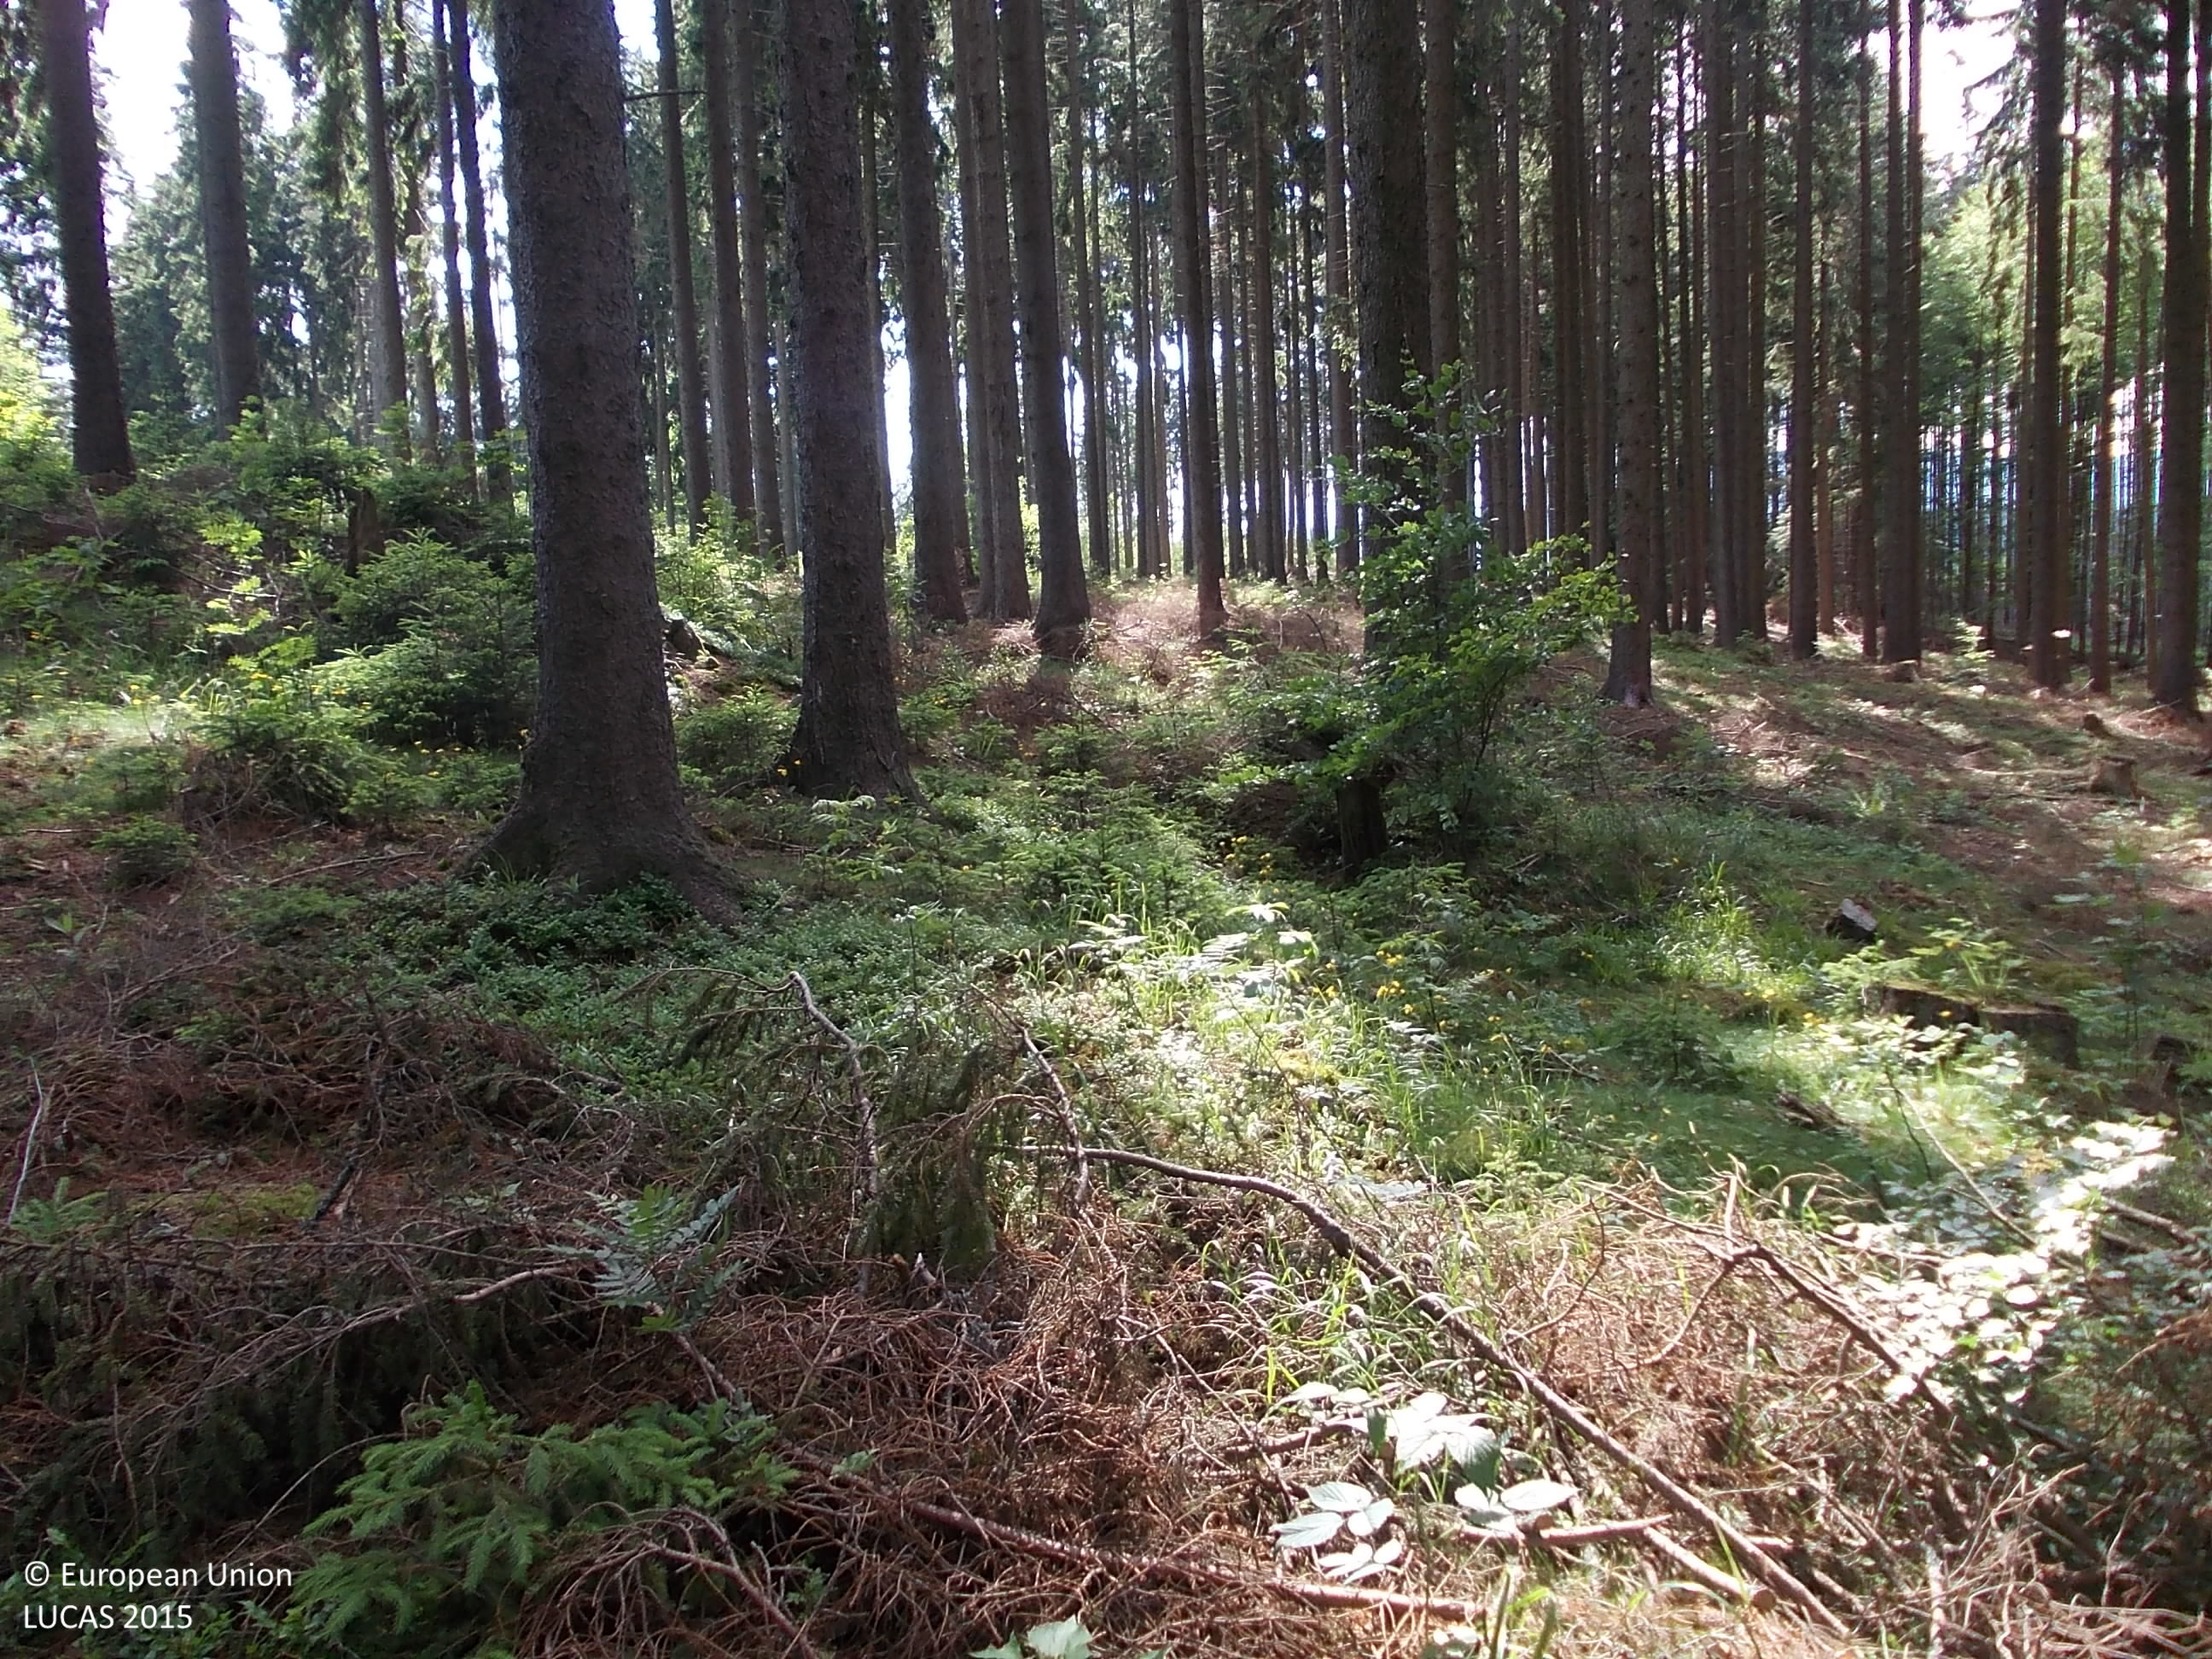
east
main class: Woodland
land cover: Spruce dominated coniferous woodland
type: hemiboreal forest and nemoral coniferous forest and mixed broadleaved-coniferous forest
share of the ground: > 75 %
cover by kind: coniferous forest trees 80 %, consolidated bare surface 10 %, herbaceous plants 5 %, lichens and mosses 5 %
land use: Forestry
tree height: > 5 m
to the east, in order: Spruce dominated coniferous woodland; Spruce dominated mixed woodland
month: June
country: CZ
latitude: 49.0437
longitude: 13.7076
